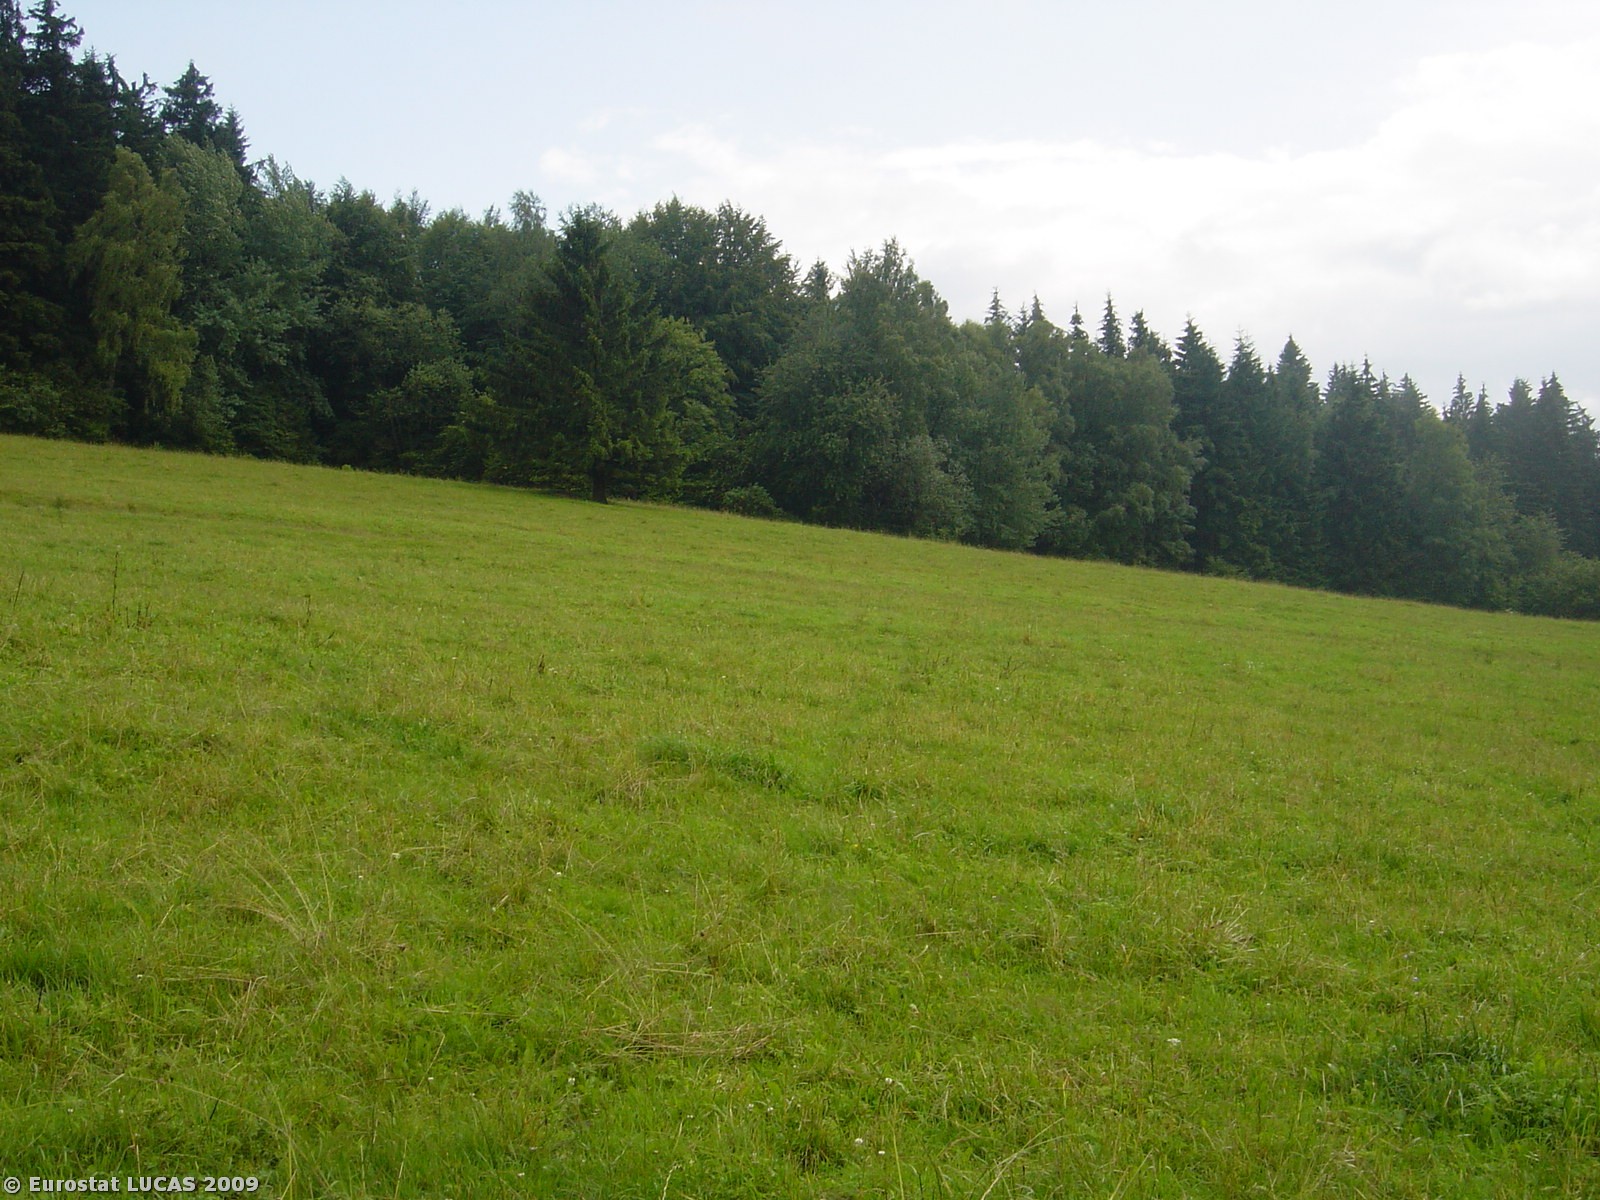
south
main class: Grassland
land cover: Grassland without tree/shrub cover
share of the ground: > 75 %
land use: Agriculture (excluding fallow land and kitchen gardens)
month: July
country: CZ
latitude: 49.6671
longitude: 12.6738
